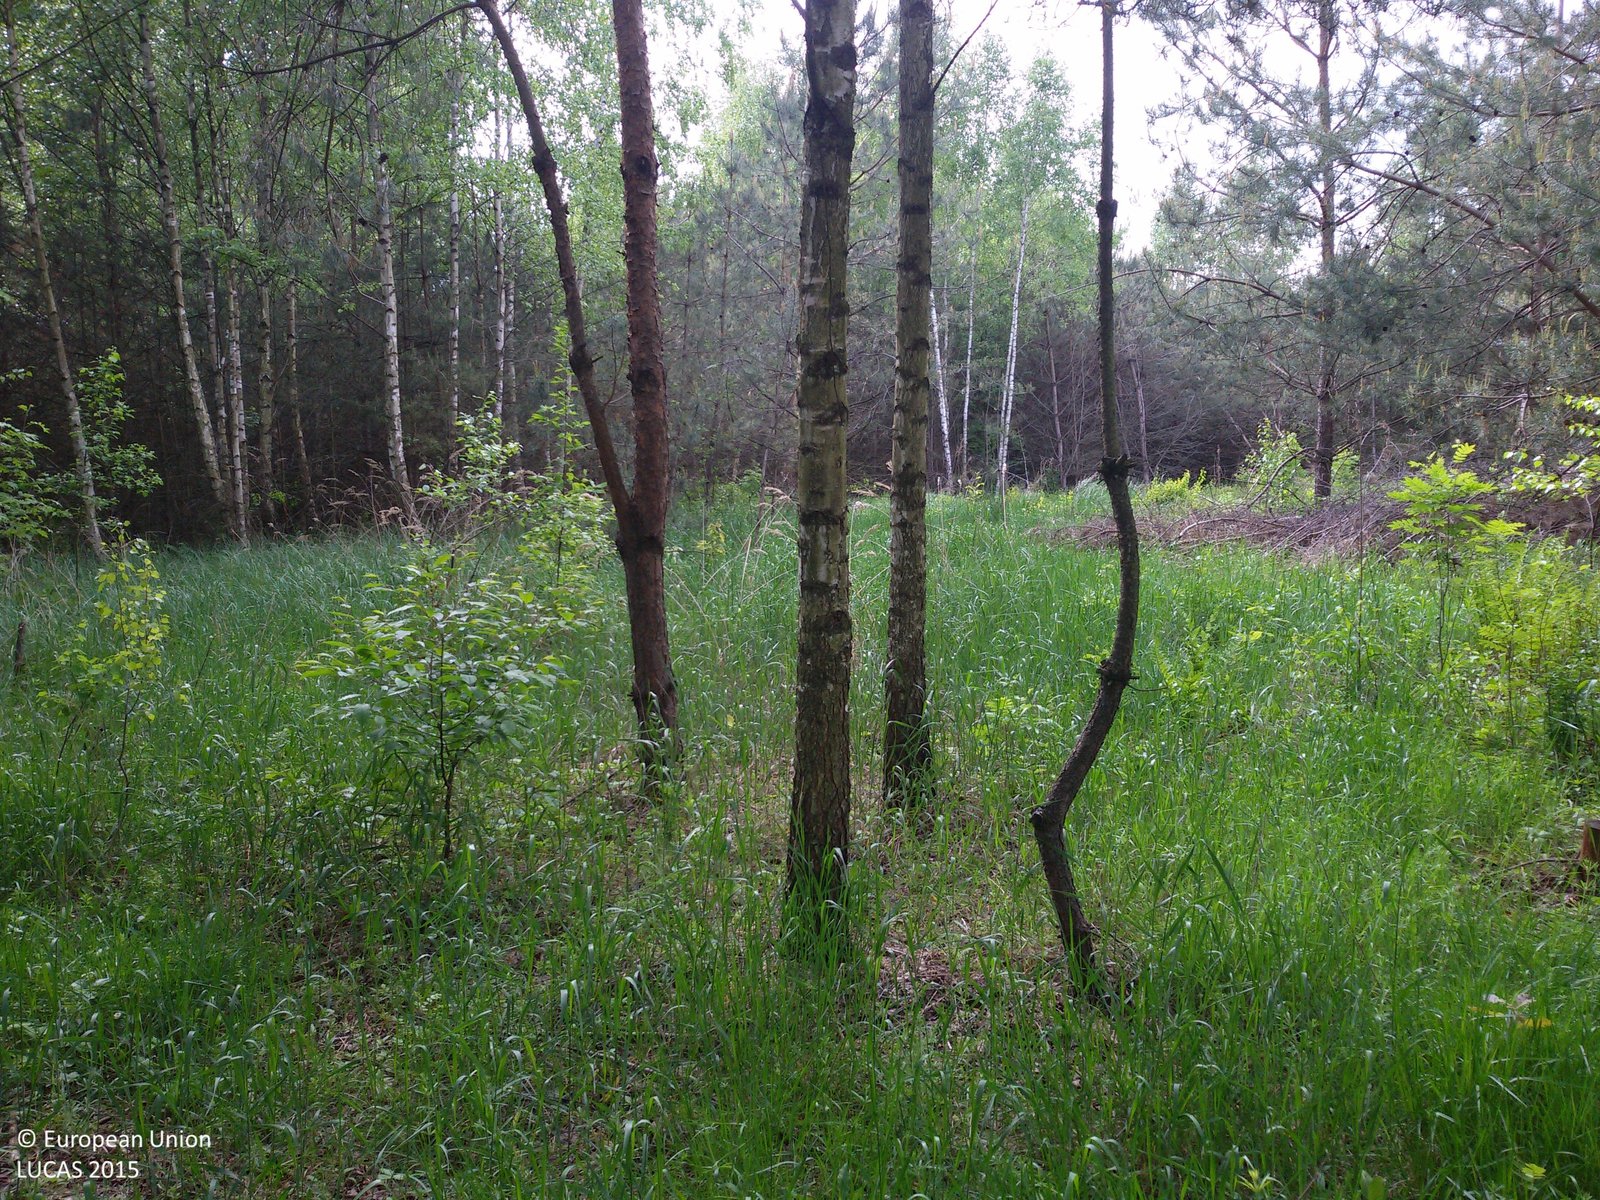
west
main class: Woodland
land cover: Pine dominated mixed woodland
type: hemiboreal forest and nemoral coniferous forest and mixed broadleaved-coniferous forest
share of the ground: > 75 %
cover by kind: coniferous forest trees 45 %, broadleaved forest trees 30 %, herbaceous plants 20 %, shrubs 5 %
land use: Forestry
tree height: > 5 m
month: May
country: PL
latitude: 51.8905
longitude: 20.7207
